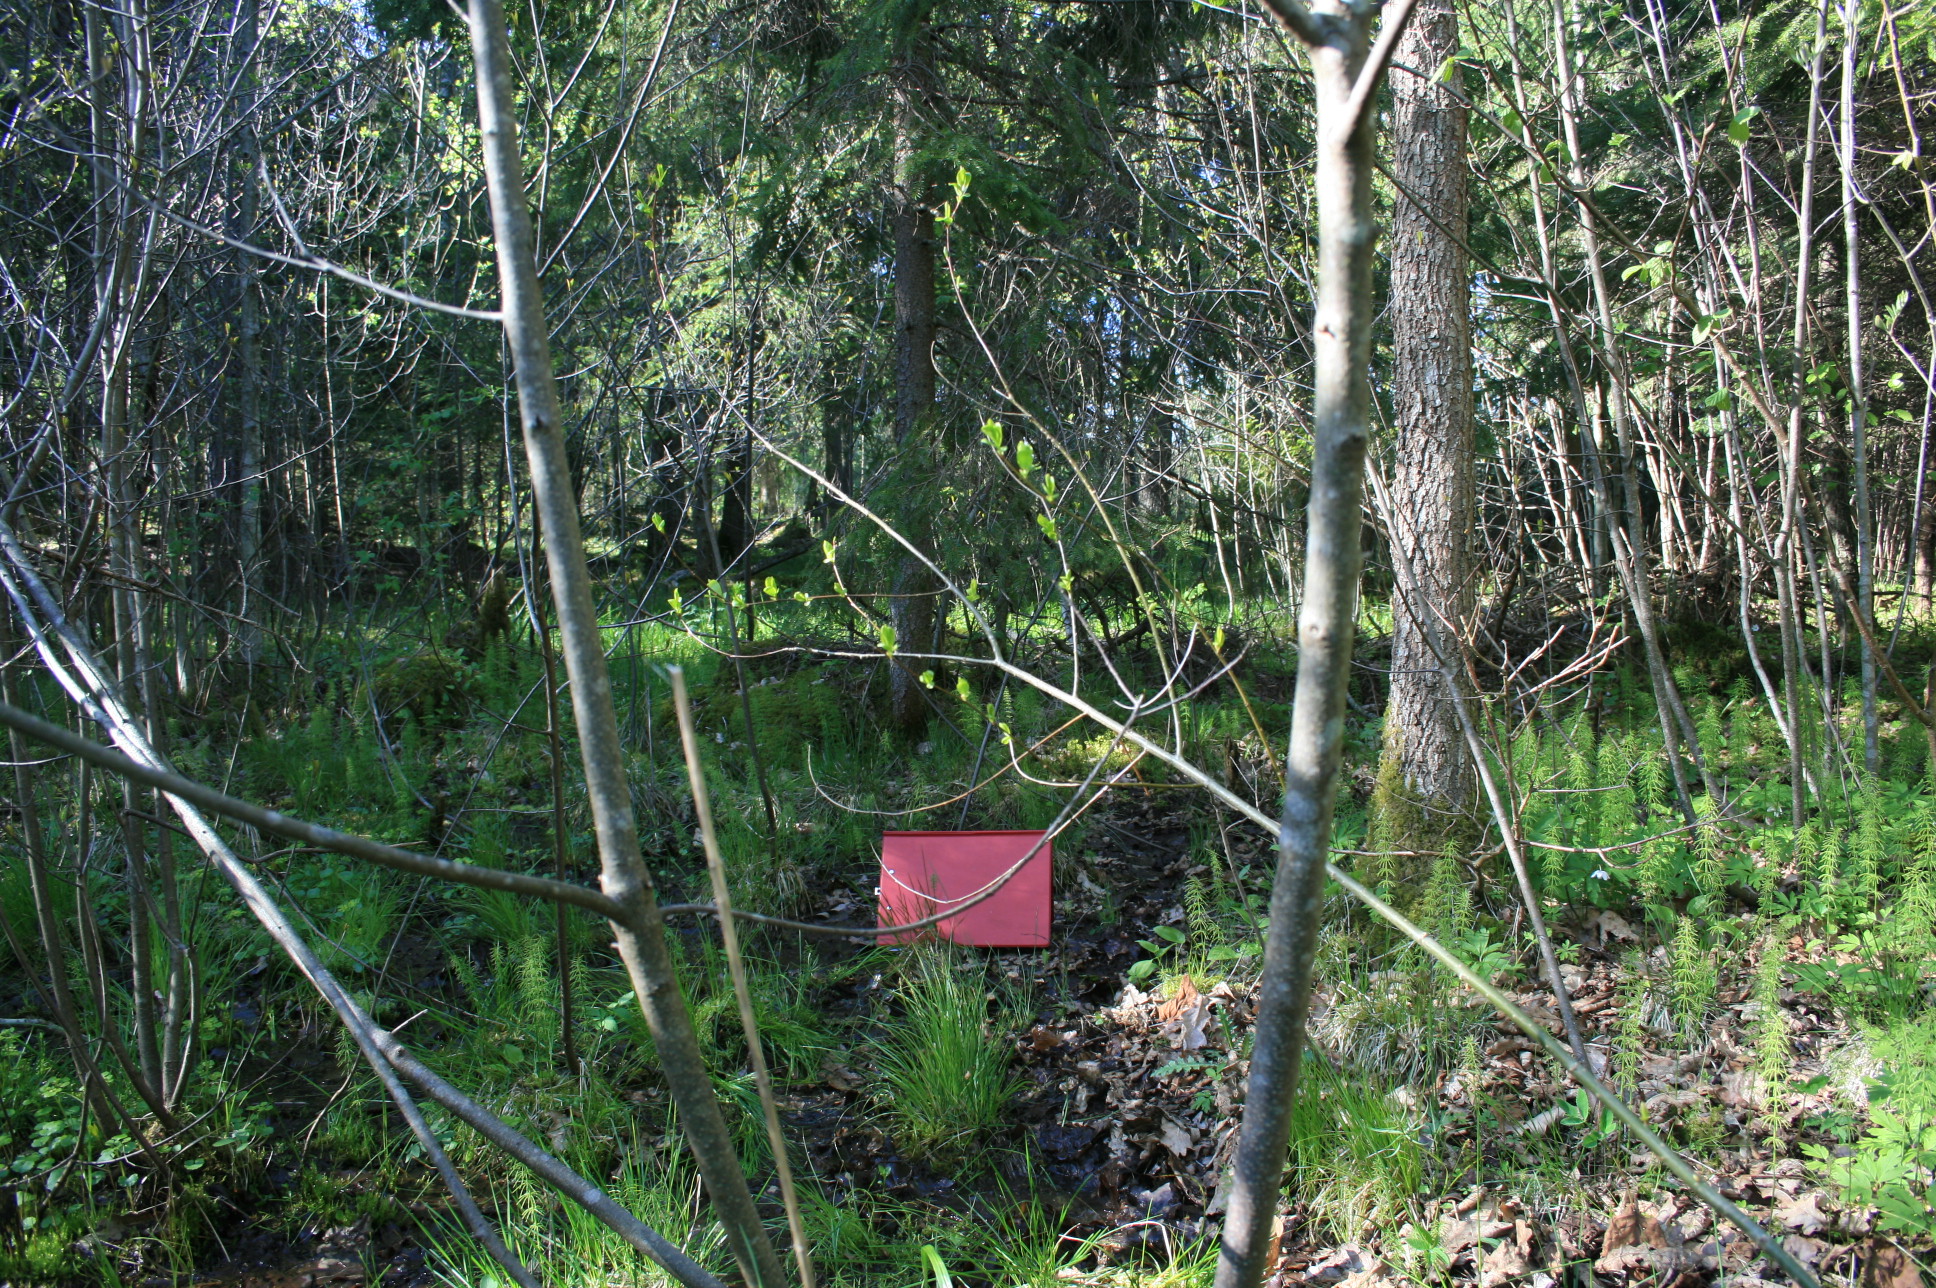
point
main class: Woodland
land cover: Other mixed woodland
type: hemiboreal forest and nemoral coniferous forest and mixed broadleaved-coniferous forest
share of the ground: > 75 %
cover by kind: coniferous forest trees 70 %, broadleaved forest trees 25 %, lichens and mosses 5 %
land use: Forestry
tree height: > 5 m
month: May
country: LT
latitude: 55.9805
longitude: 21.4708
